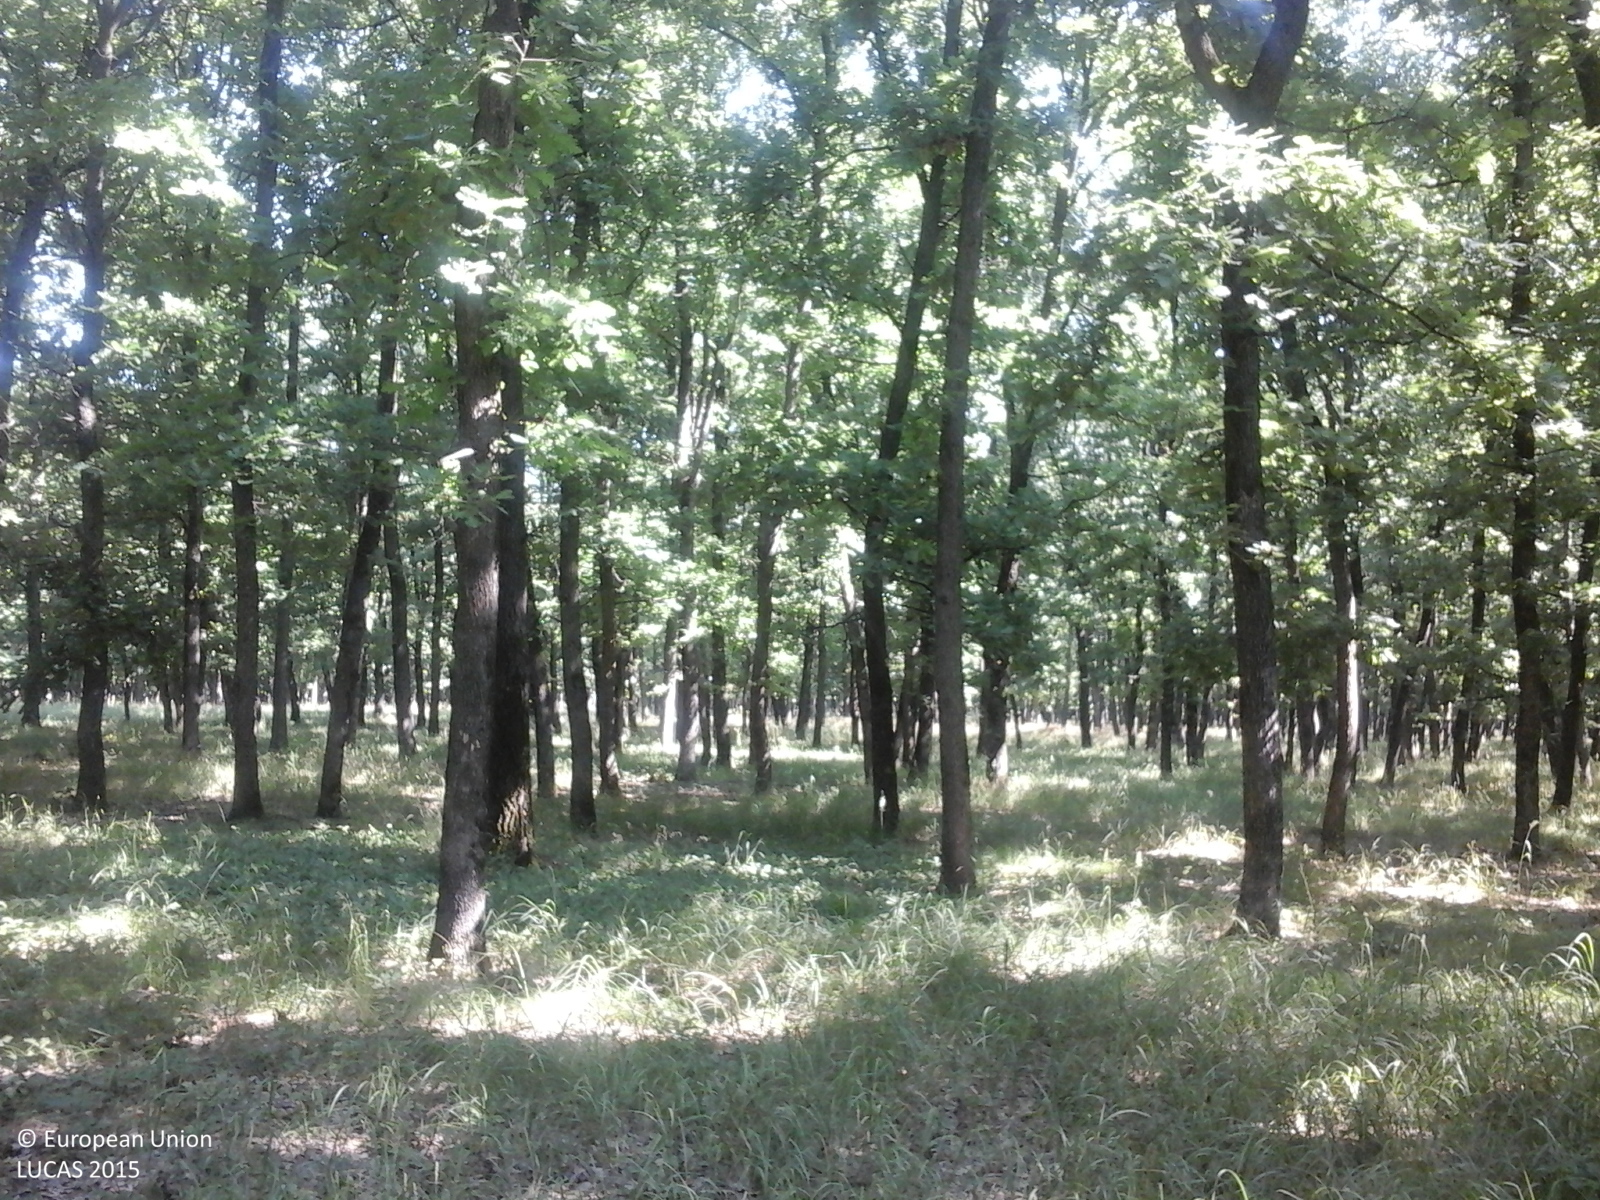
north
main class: Woodland
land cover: Broadleaved woodland
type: thermophilous deciduous forest
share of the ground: > 75 %
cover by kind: broadleaved forest trees 100 %
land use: Forestry
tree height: > 5 m
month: July
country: RO
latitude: 44.4539
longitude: 24.1519
